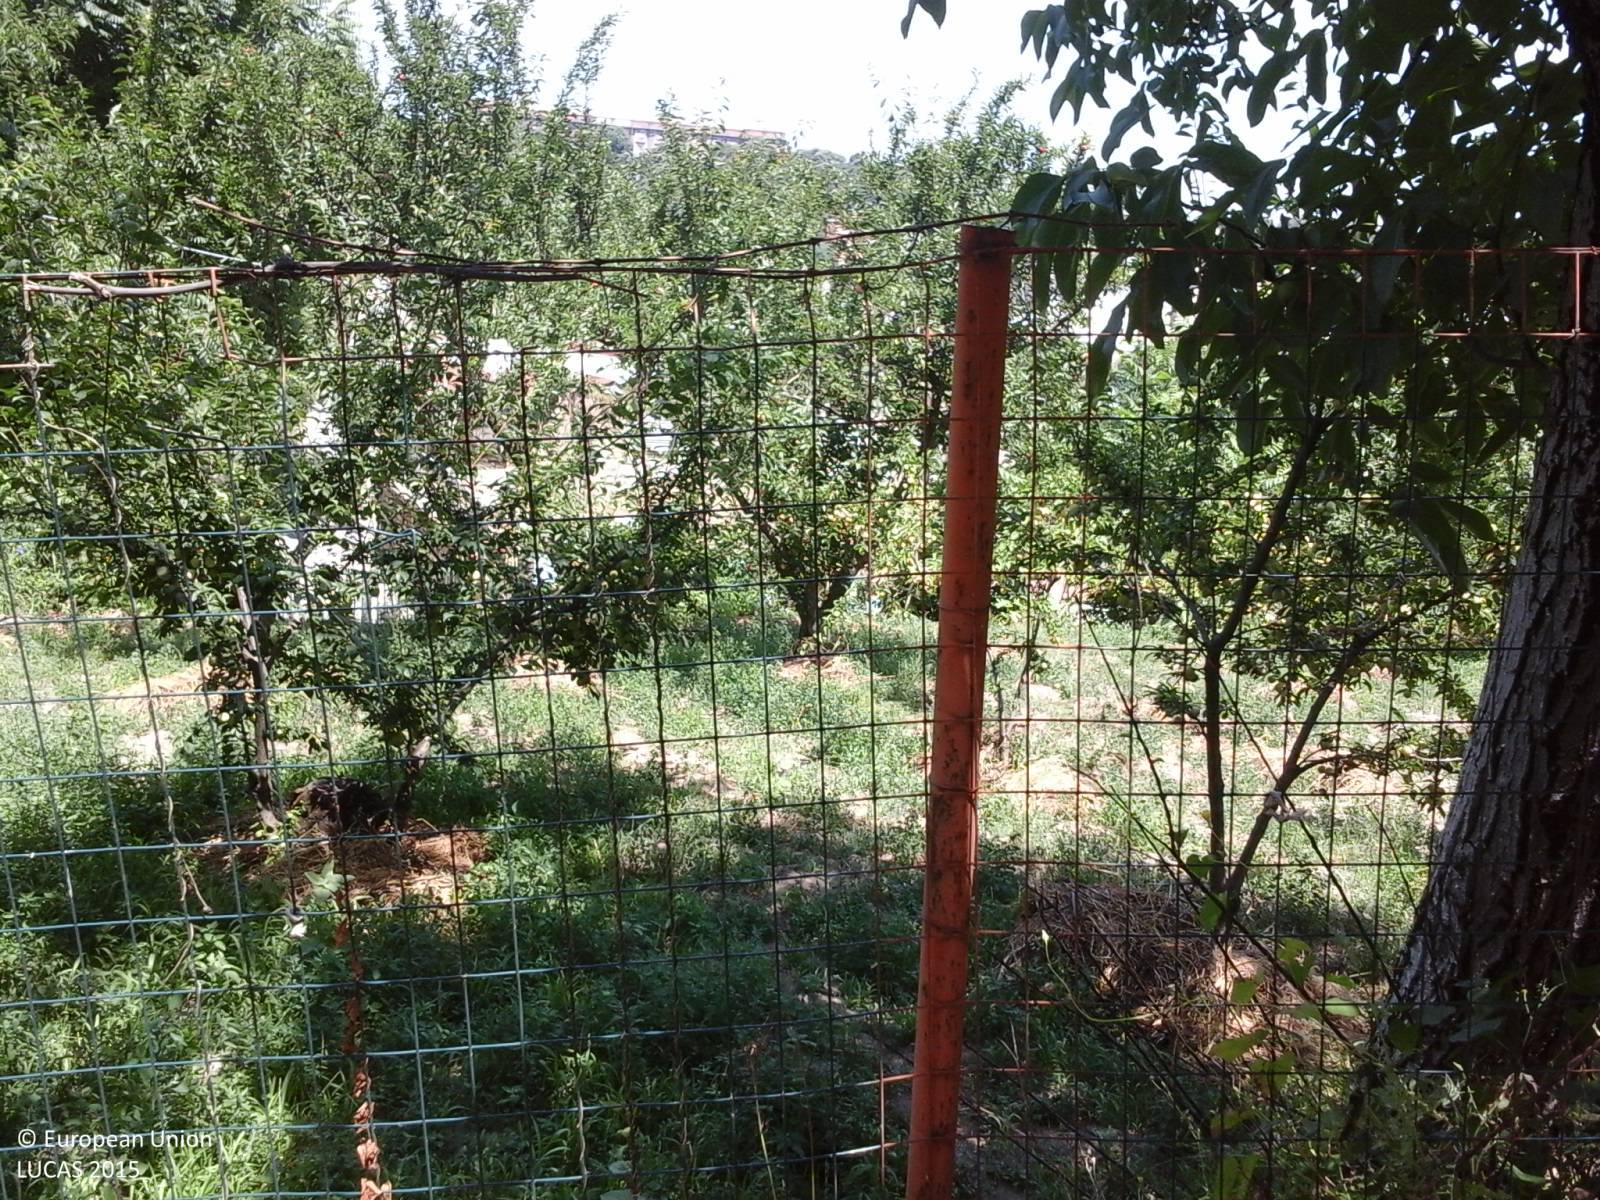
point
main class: Cropland
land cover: Other fruit trees and berries
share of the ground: > 75 %
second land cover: Spontaneously vegetated surfaces
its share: > 75 %
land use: Agriculture (excluding fallow land and kitchen gardens)
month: June
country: IT
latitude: 40.8641
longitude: 14.2415
